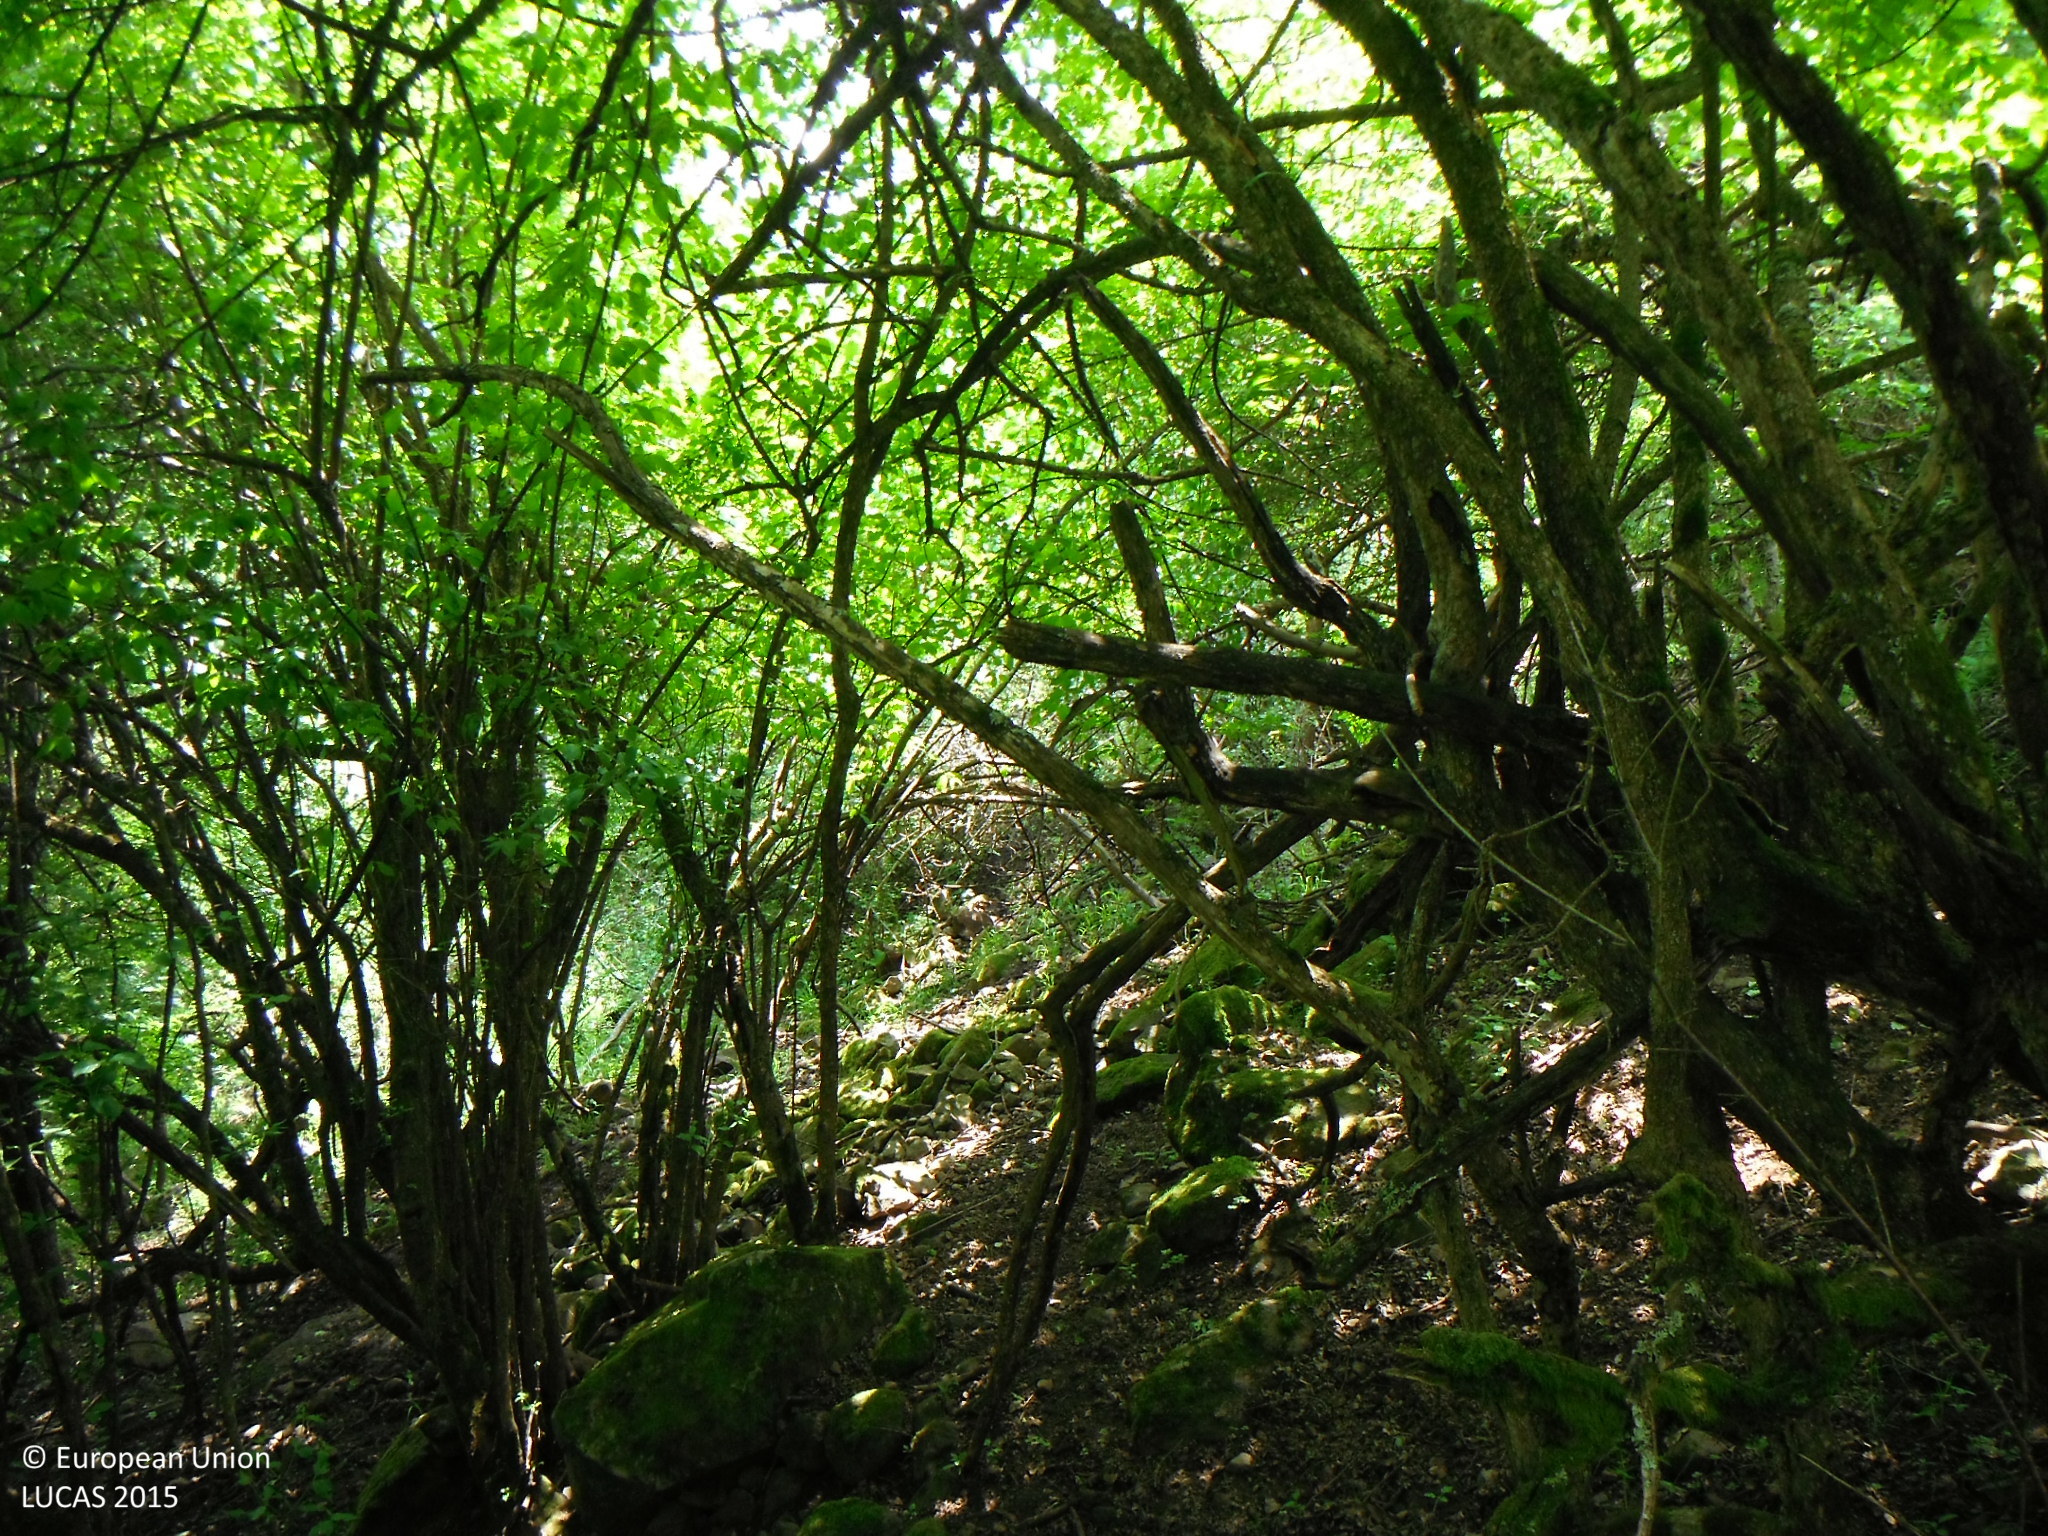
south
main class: Woodland
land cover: Broadleaved woodland
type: mesophytic deciduous forest
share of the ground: > 75 %
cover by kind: broadleaved forest trees 100 %
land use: Forestry
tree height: > 5 m
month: June
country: SK
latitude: 48.3998
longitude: 19.4112
